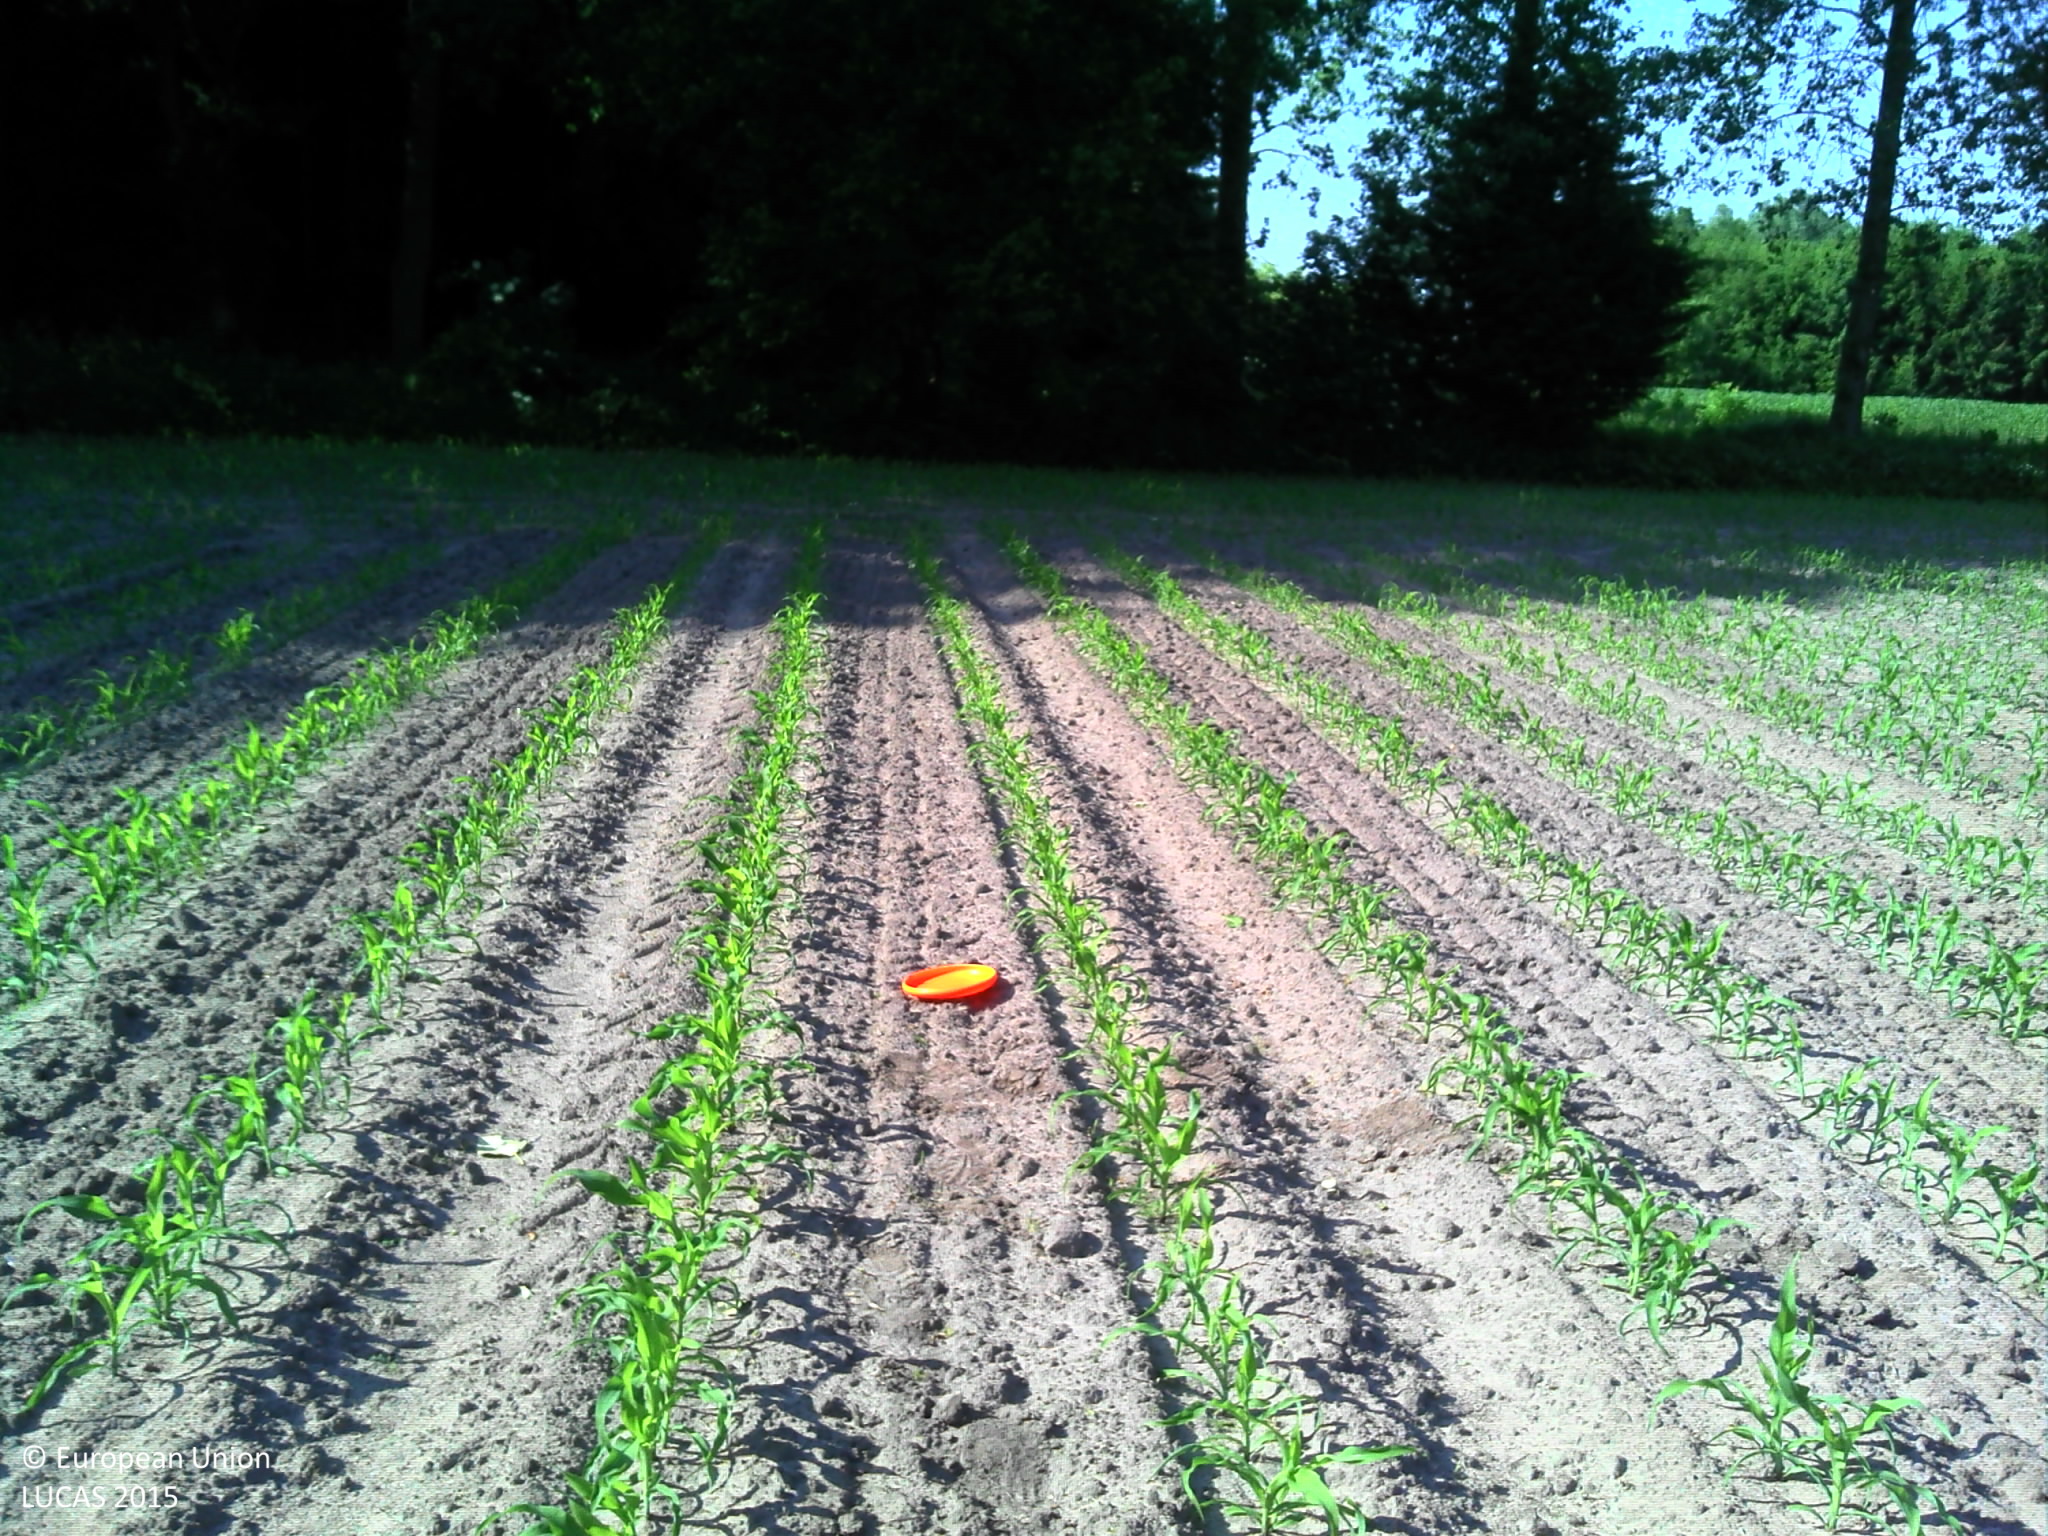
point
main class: Cropland
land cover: Maize
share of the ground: 10 - 25 %
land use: Agriculture (excluding fallow land and kitchen gardens)
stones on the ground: < 10 %
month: June
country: BE
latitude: 51.0086
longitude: 3.8222
